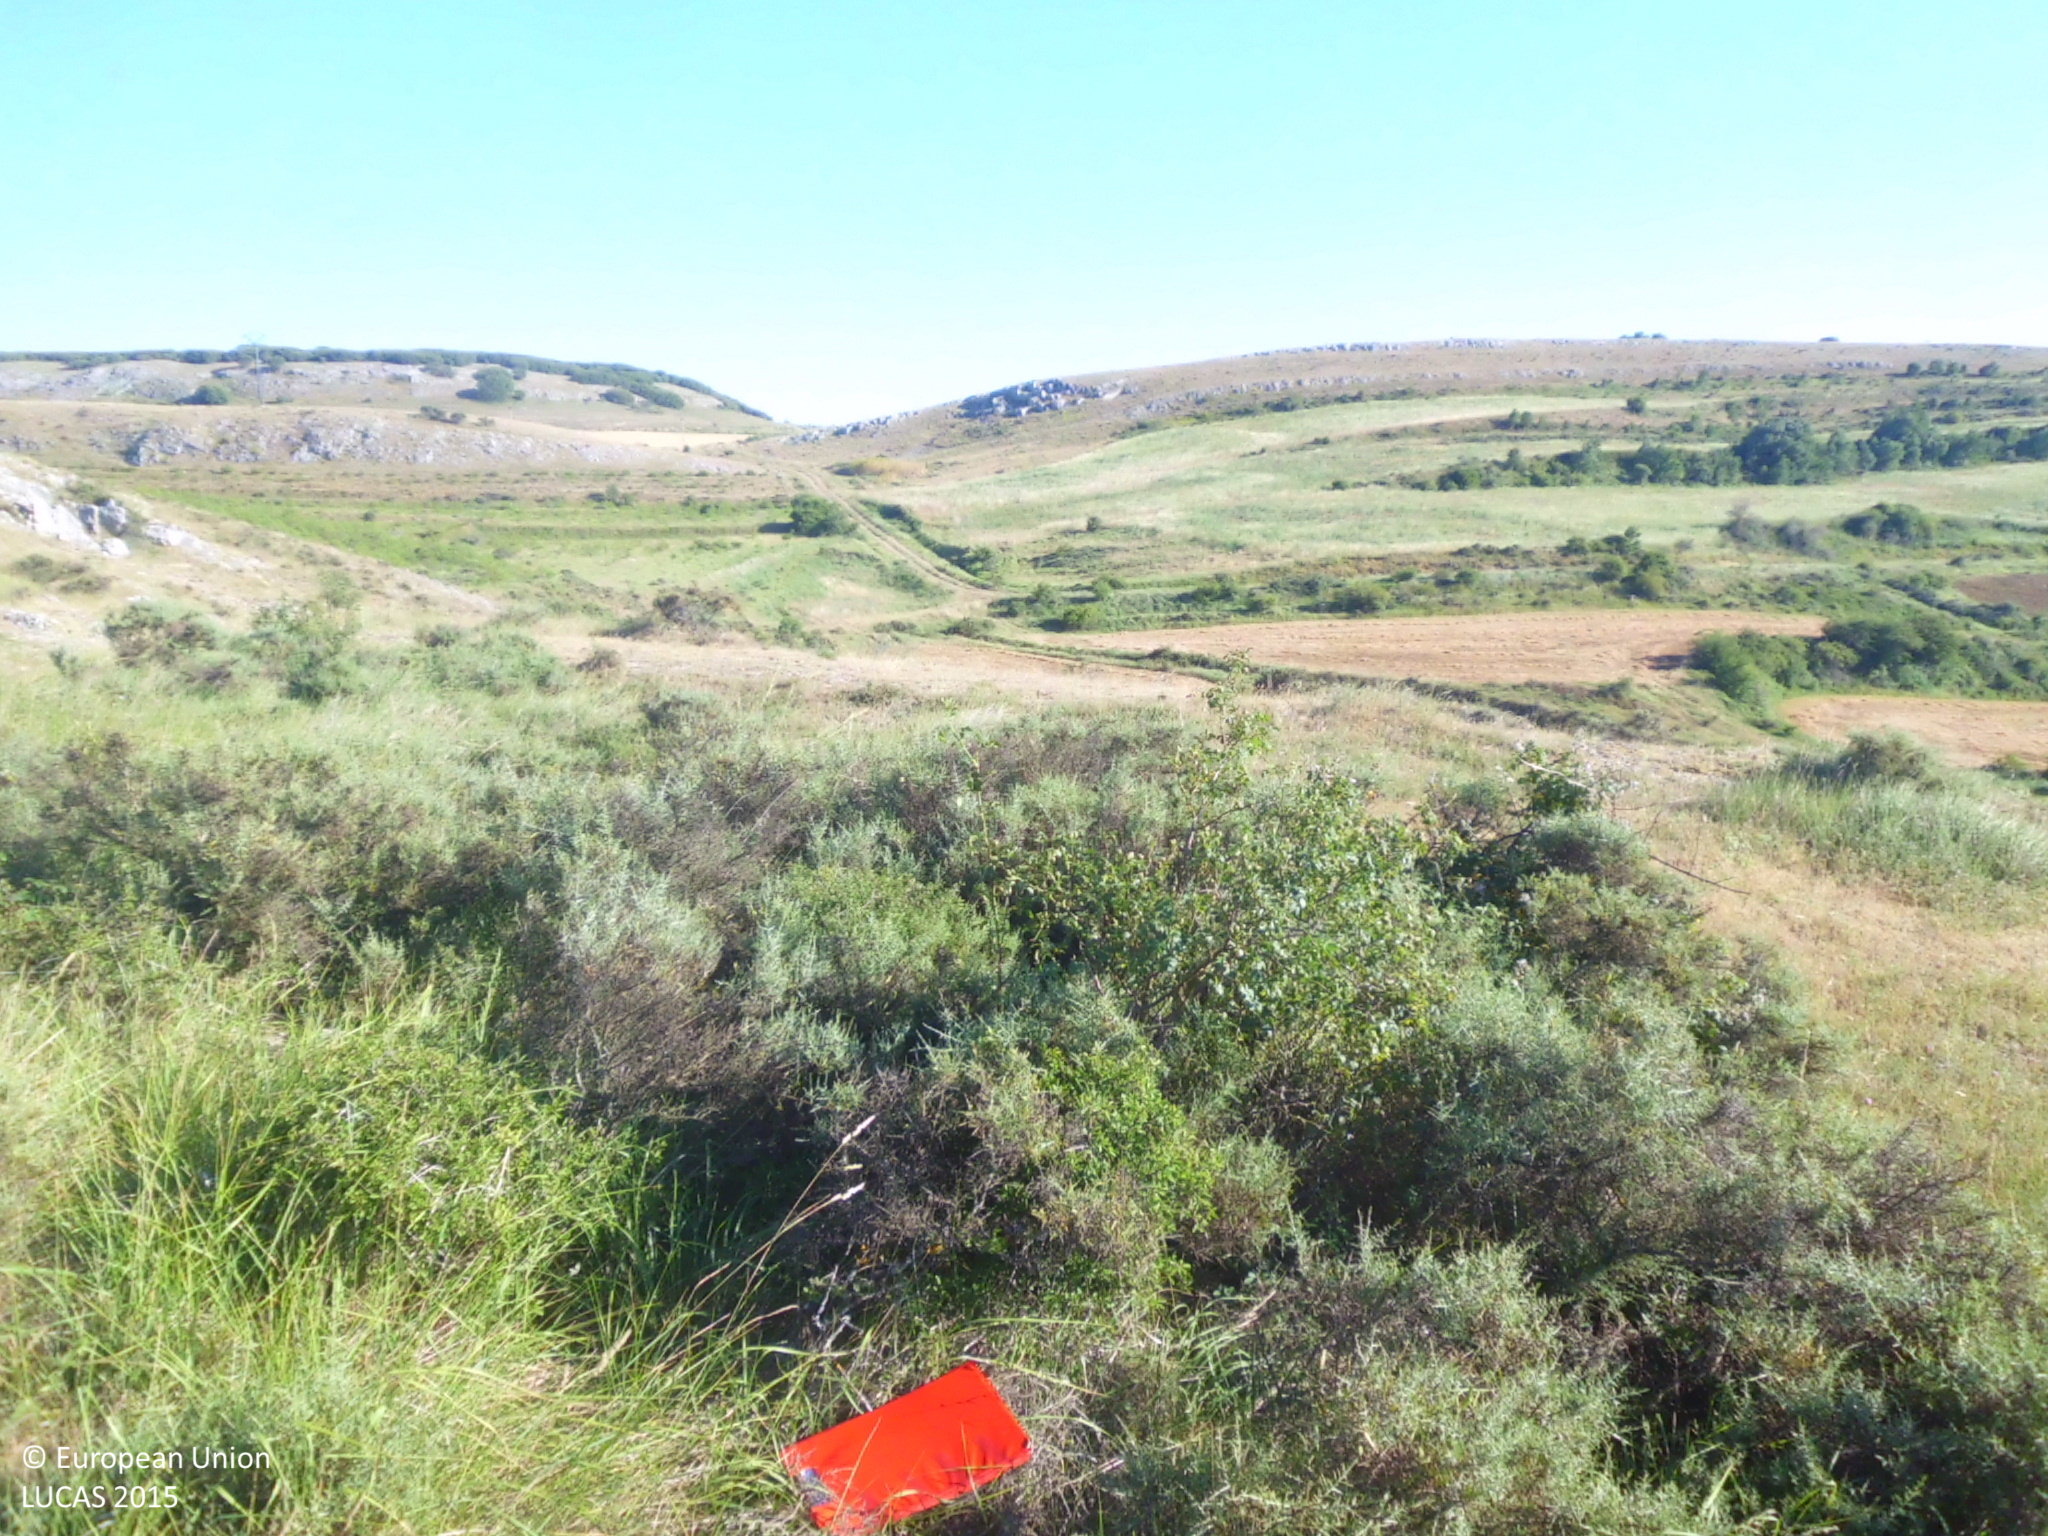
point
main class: Shrubland
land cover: Shrubland without tree cover
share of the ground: 50 - 75 %
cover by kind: shrubs 65 %, consolidated bare surface 20 %, herbaceous plants 15 %
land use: Abandoned areas
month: July
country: ES
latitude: 42.6641
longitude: -4.2623
